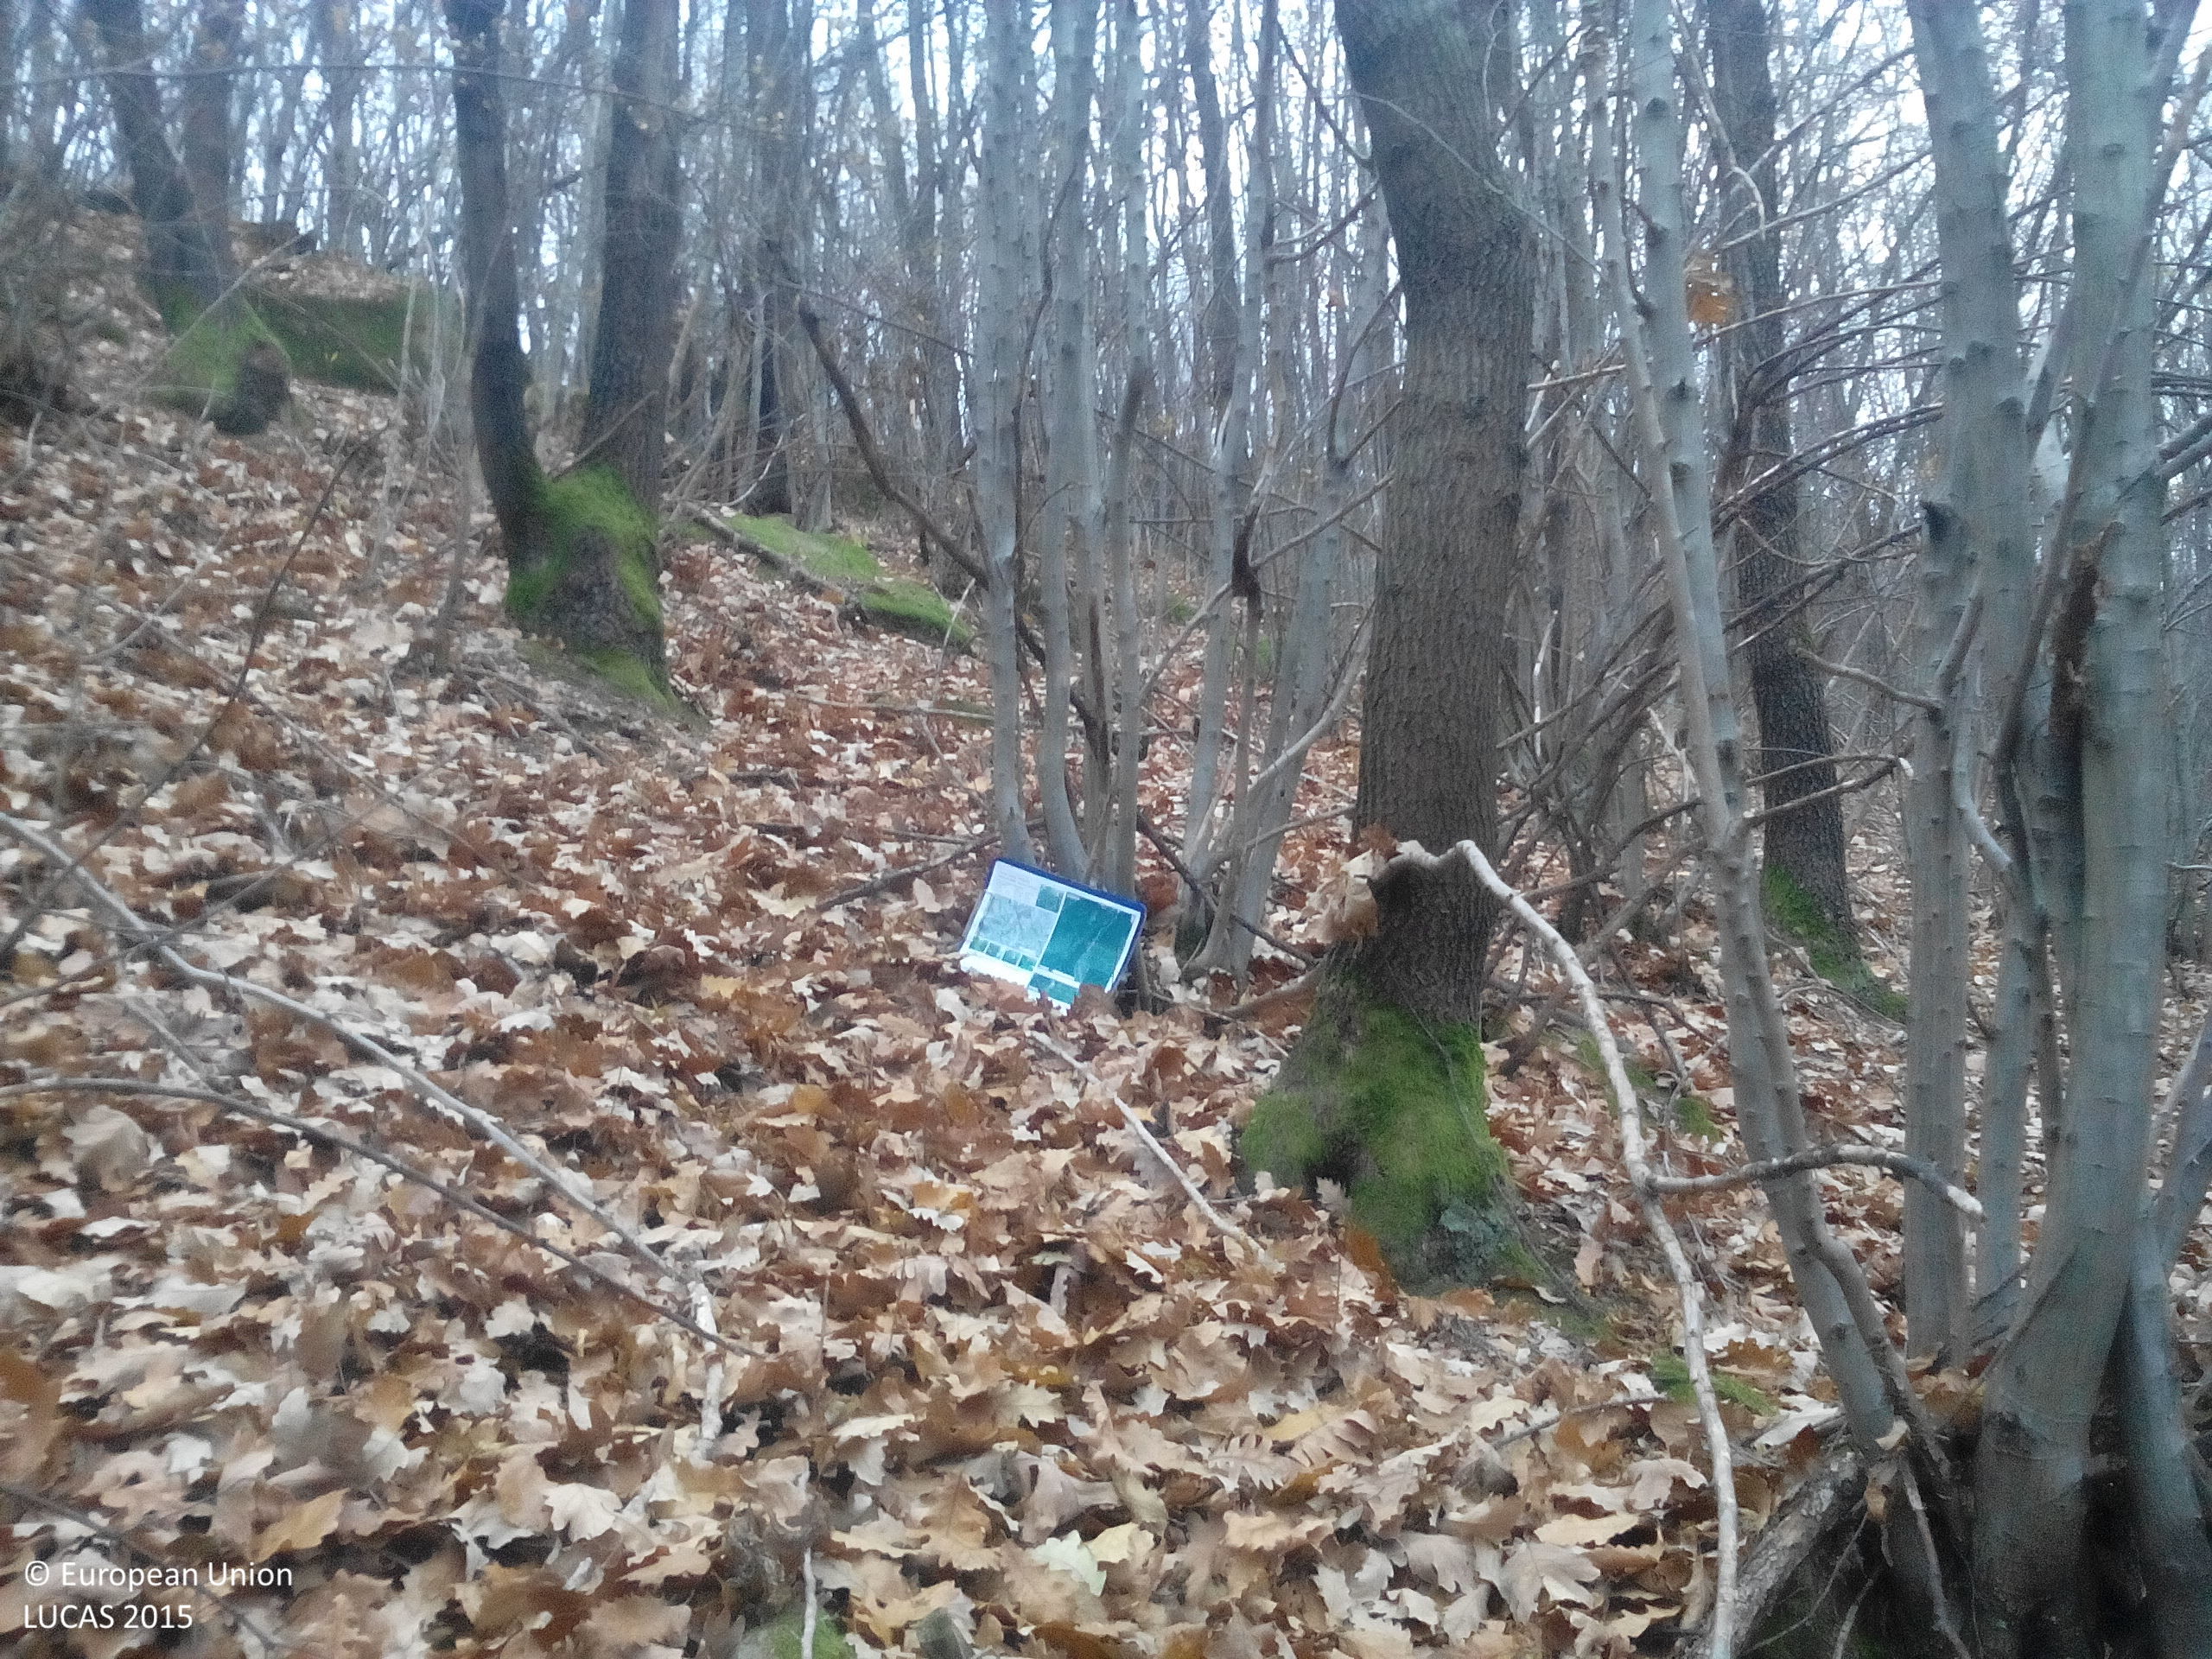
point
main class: Woodland
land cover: Broadleaved woodland
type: mesophytic deciduous forest
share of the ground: > 75 %
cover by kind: broadleaved forest trees 100 %
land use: Forestry
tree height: > 5 m
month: November
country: BG
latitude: 43.0809
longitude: 23.7647
